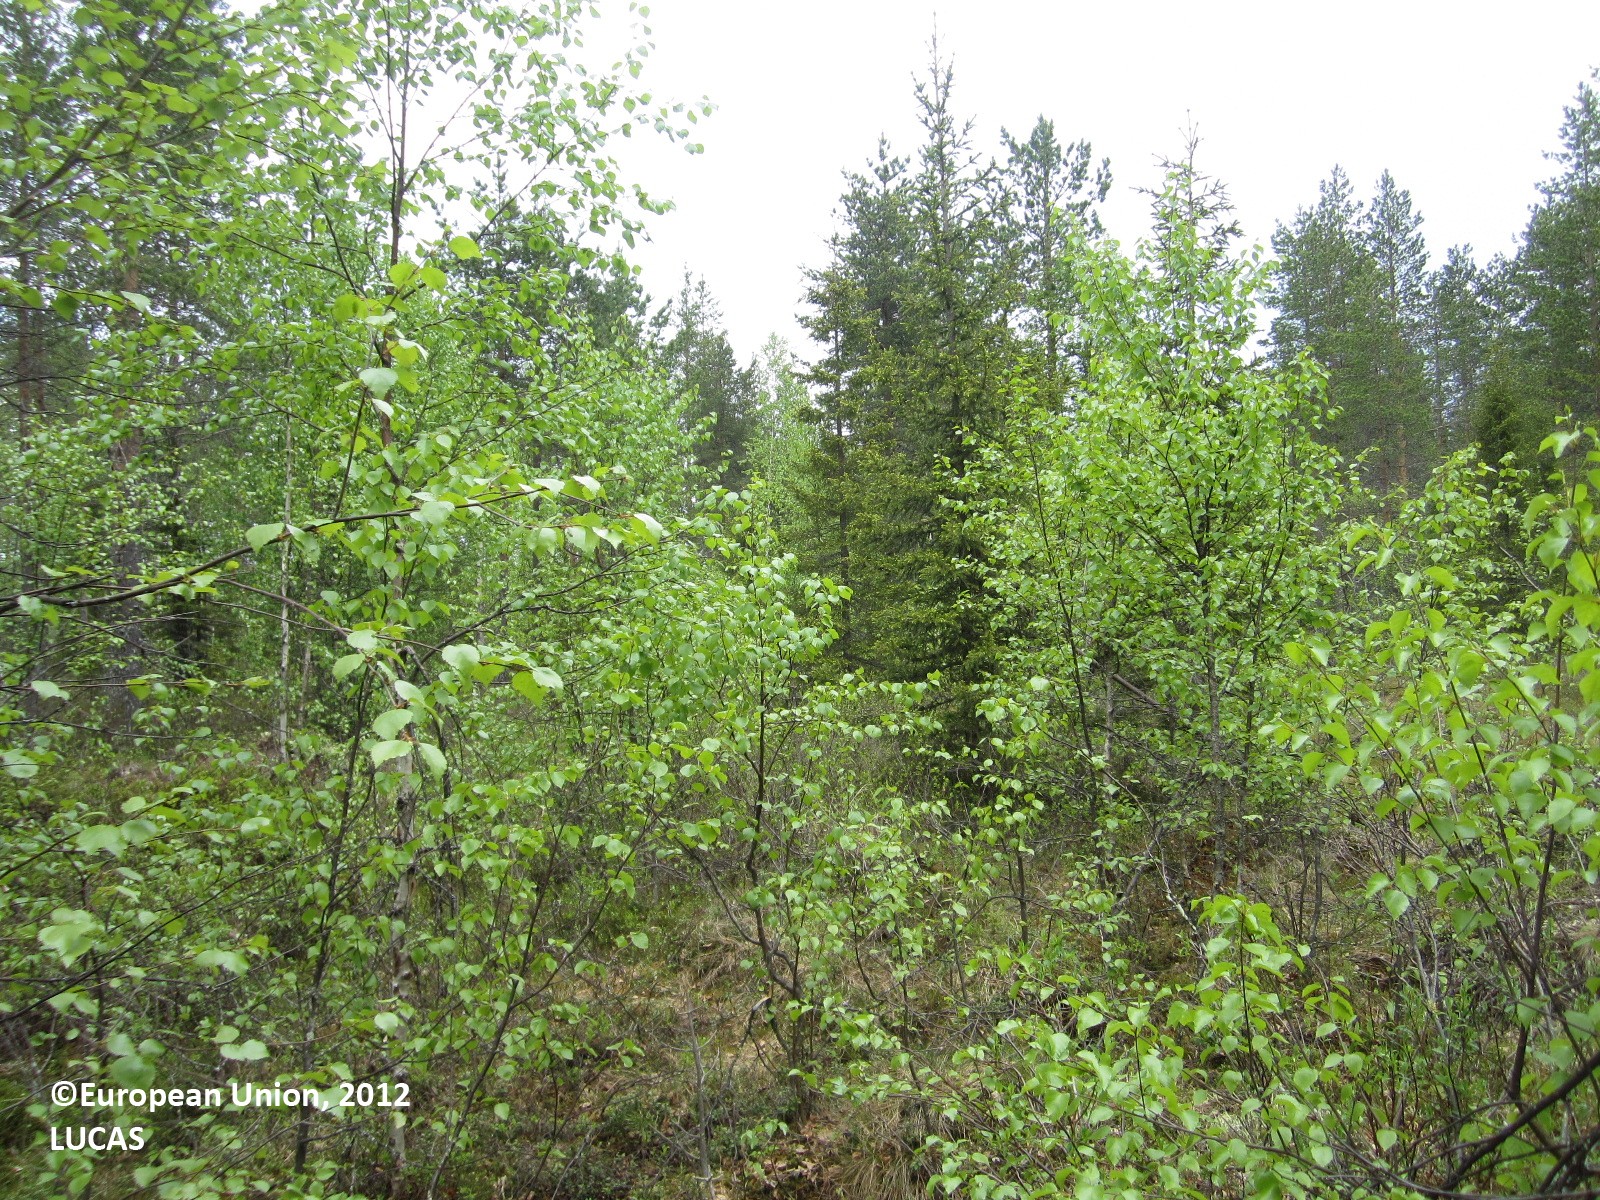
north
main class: Woodland
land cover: Pine dominated mixed woodland
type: boreal forest
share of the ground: 25 - 50 %
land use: Forestry
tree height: > 5 m
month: June
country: FI
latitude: 64.5480
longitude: 28.6370
